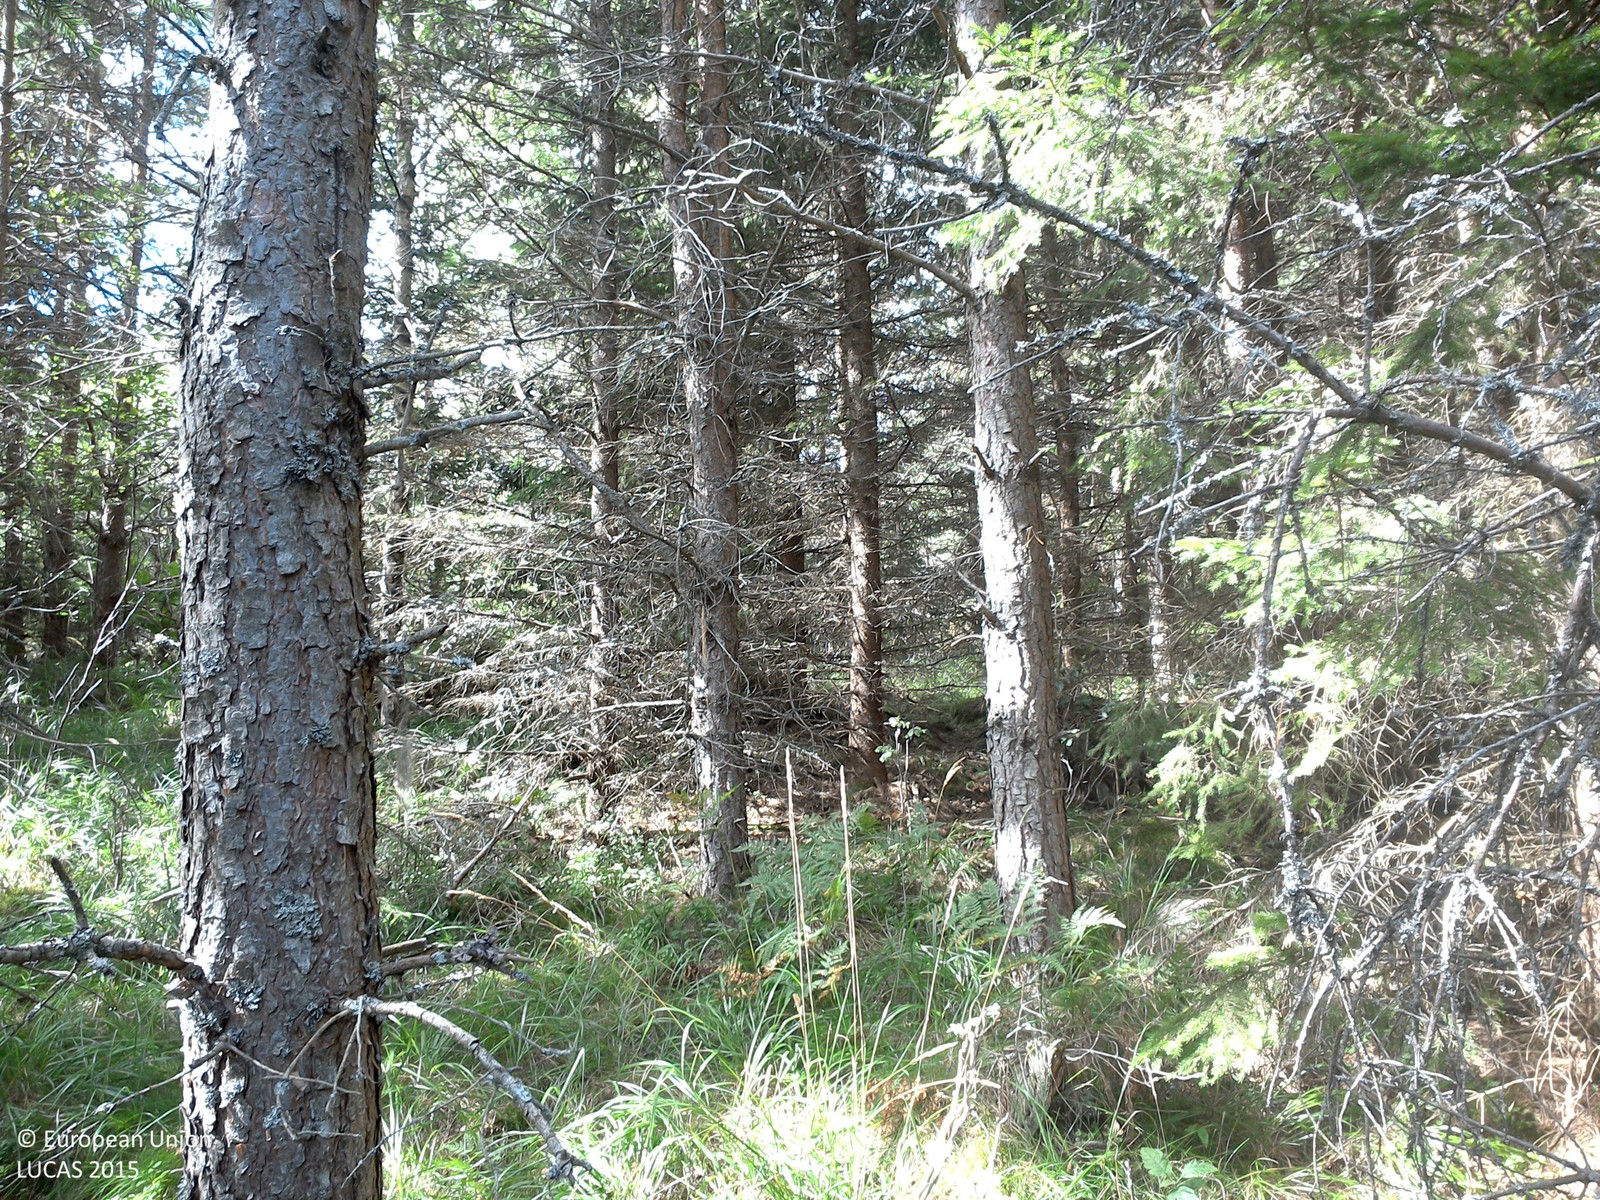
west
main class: Woodland
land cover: Pine dominated mixed woodland
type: boreal forest
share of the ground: 50 - 75 %
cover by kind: coniferous forest trees 50 %, broadleaved forest trees 20 %, herbaceous plants 20 %, lichens and mosses 10 %
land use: Forestry
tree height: > 5 m
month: August
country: SE
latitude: 57.9053
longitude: 15.5814
